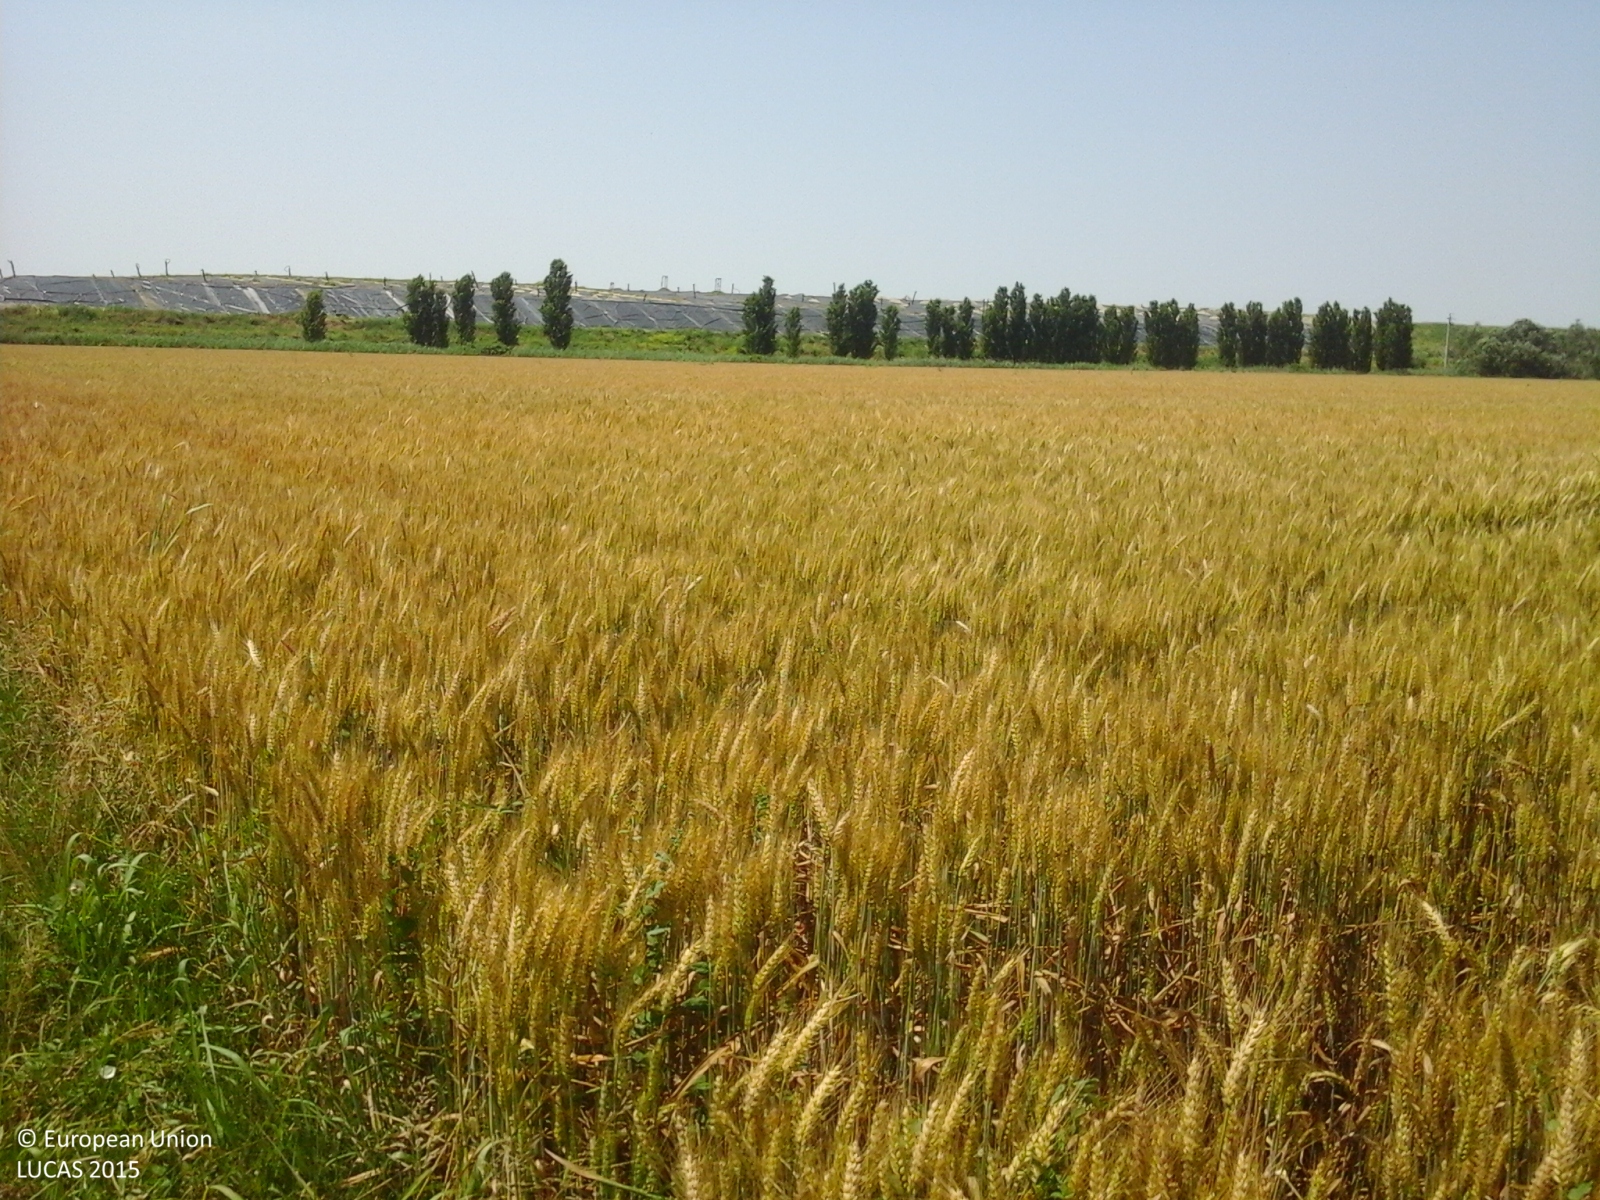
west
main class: Cropland
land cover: Common wheat
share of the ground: > 75 %
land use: Agriculture (excluding fallow land and kitchen gardens)
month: June
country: IT
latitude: 44.7246
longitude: 12.1799
